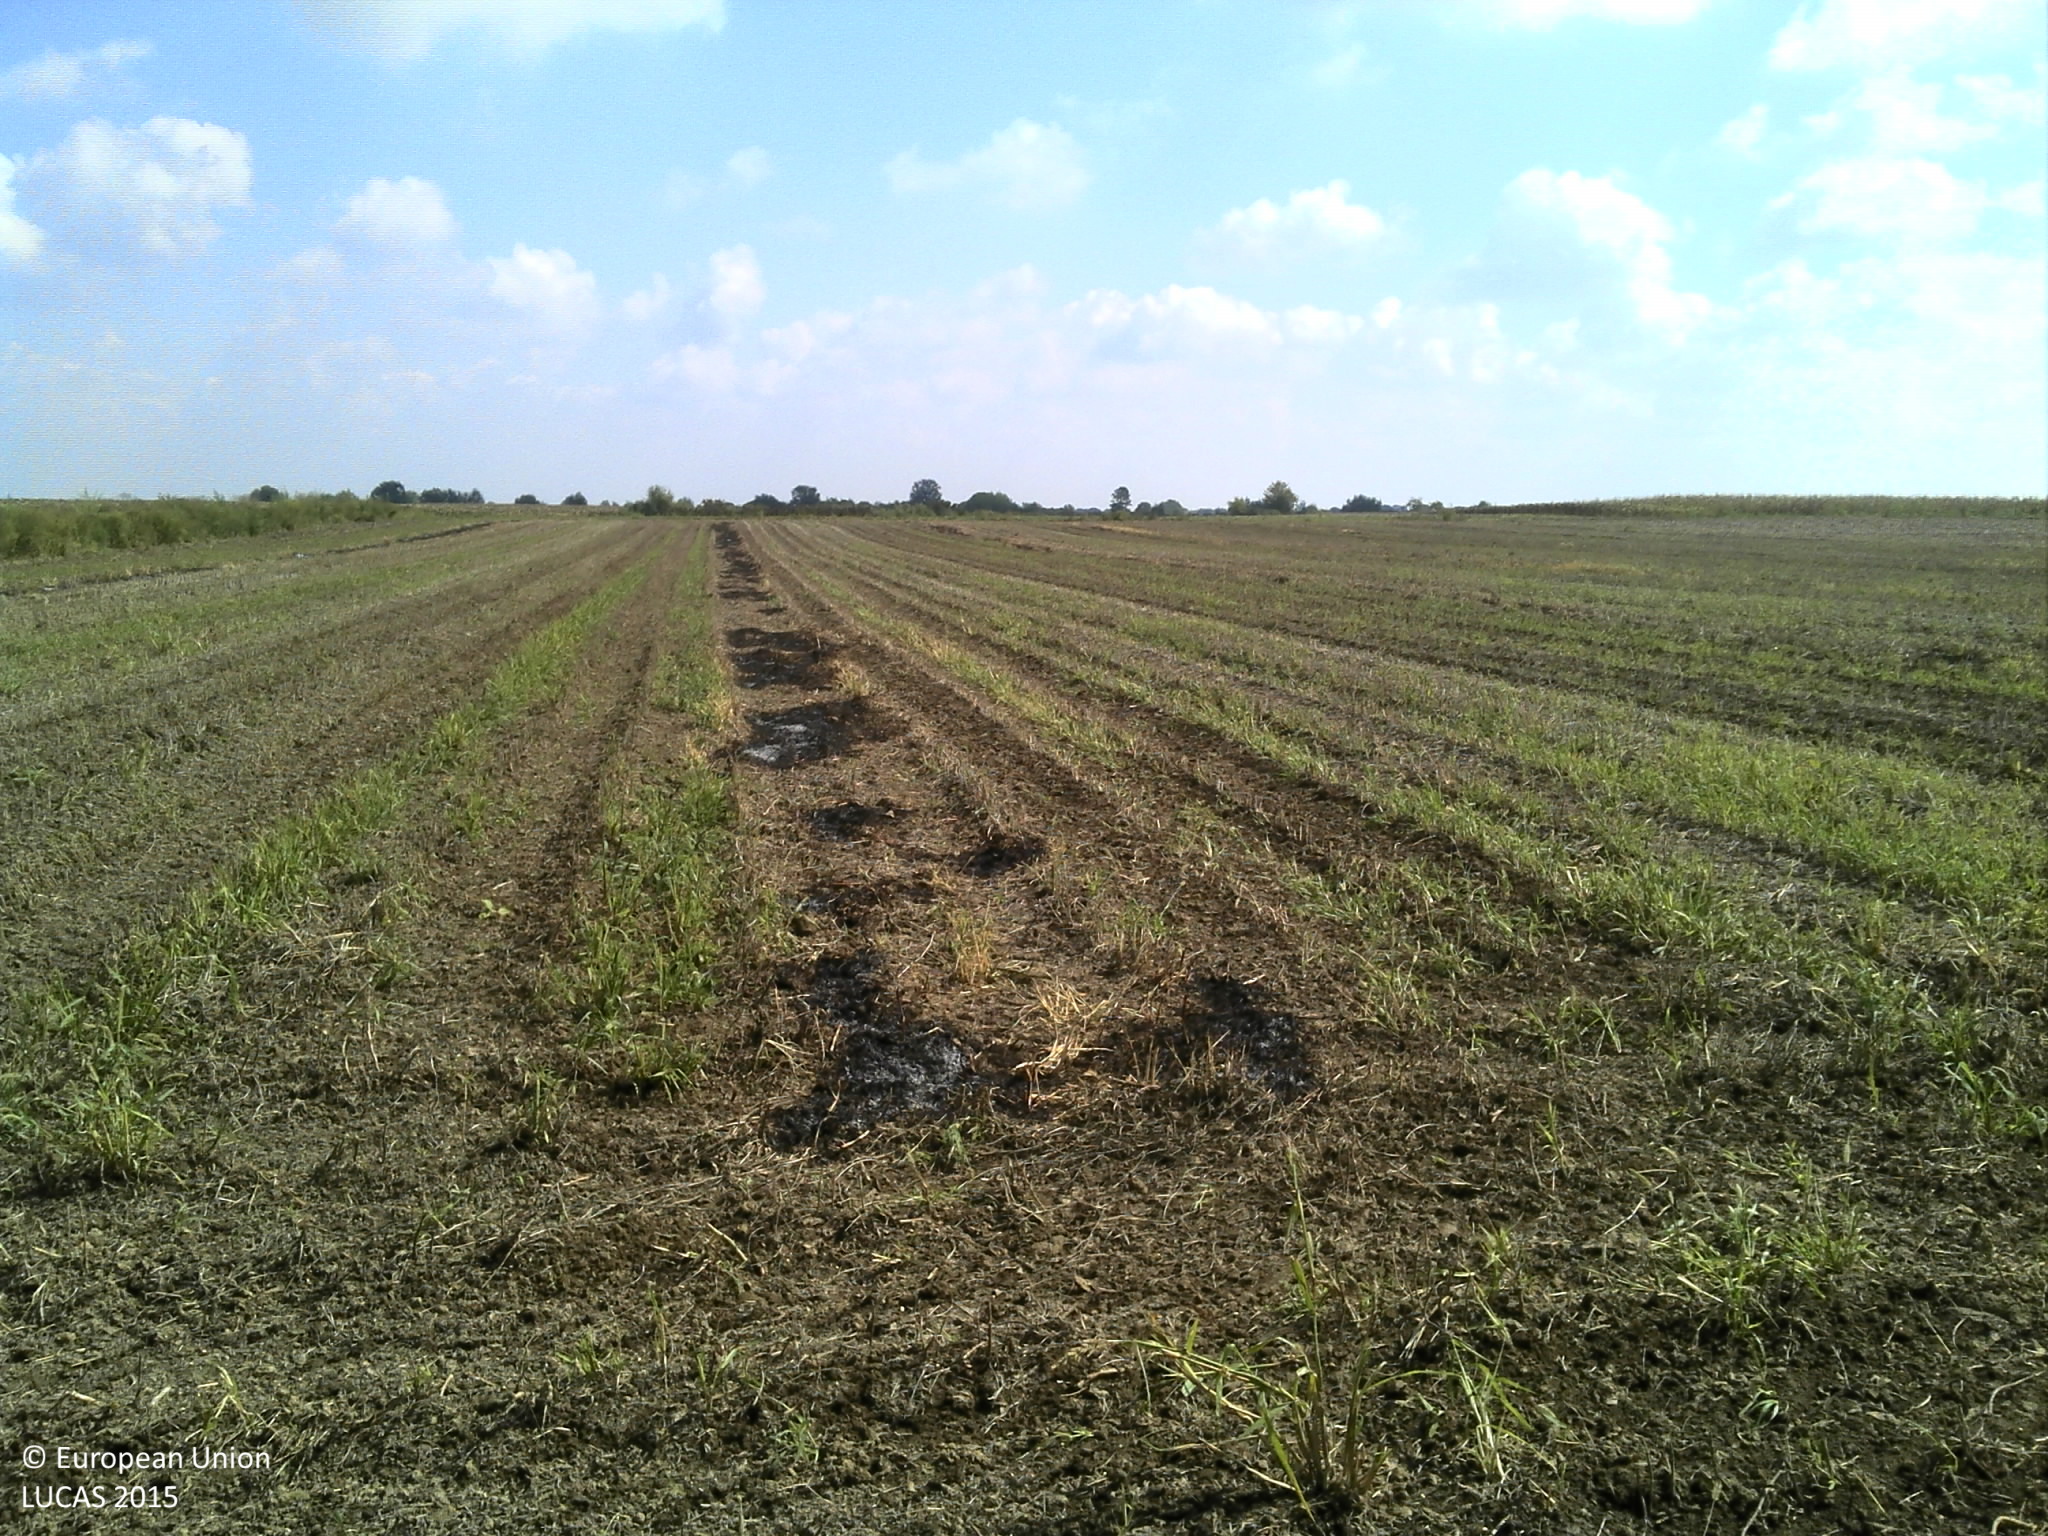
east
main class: Cropland
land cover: Soya
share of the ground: < 10 %
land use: Agriculture (excluding fallow land and kitchen gardens)
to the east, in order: Soya; Tracks; Sunflower
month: September
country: HR
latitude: 45.1398
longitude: 18.9730
